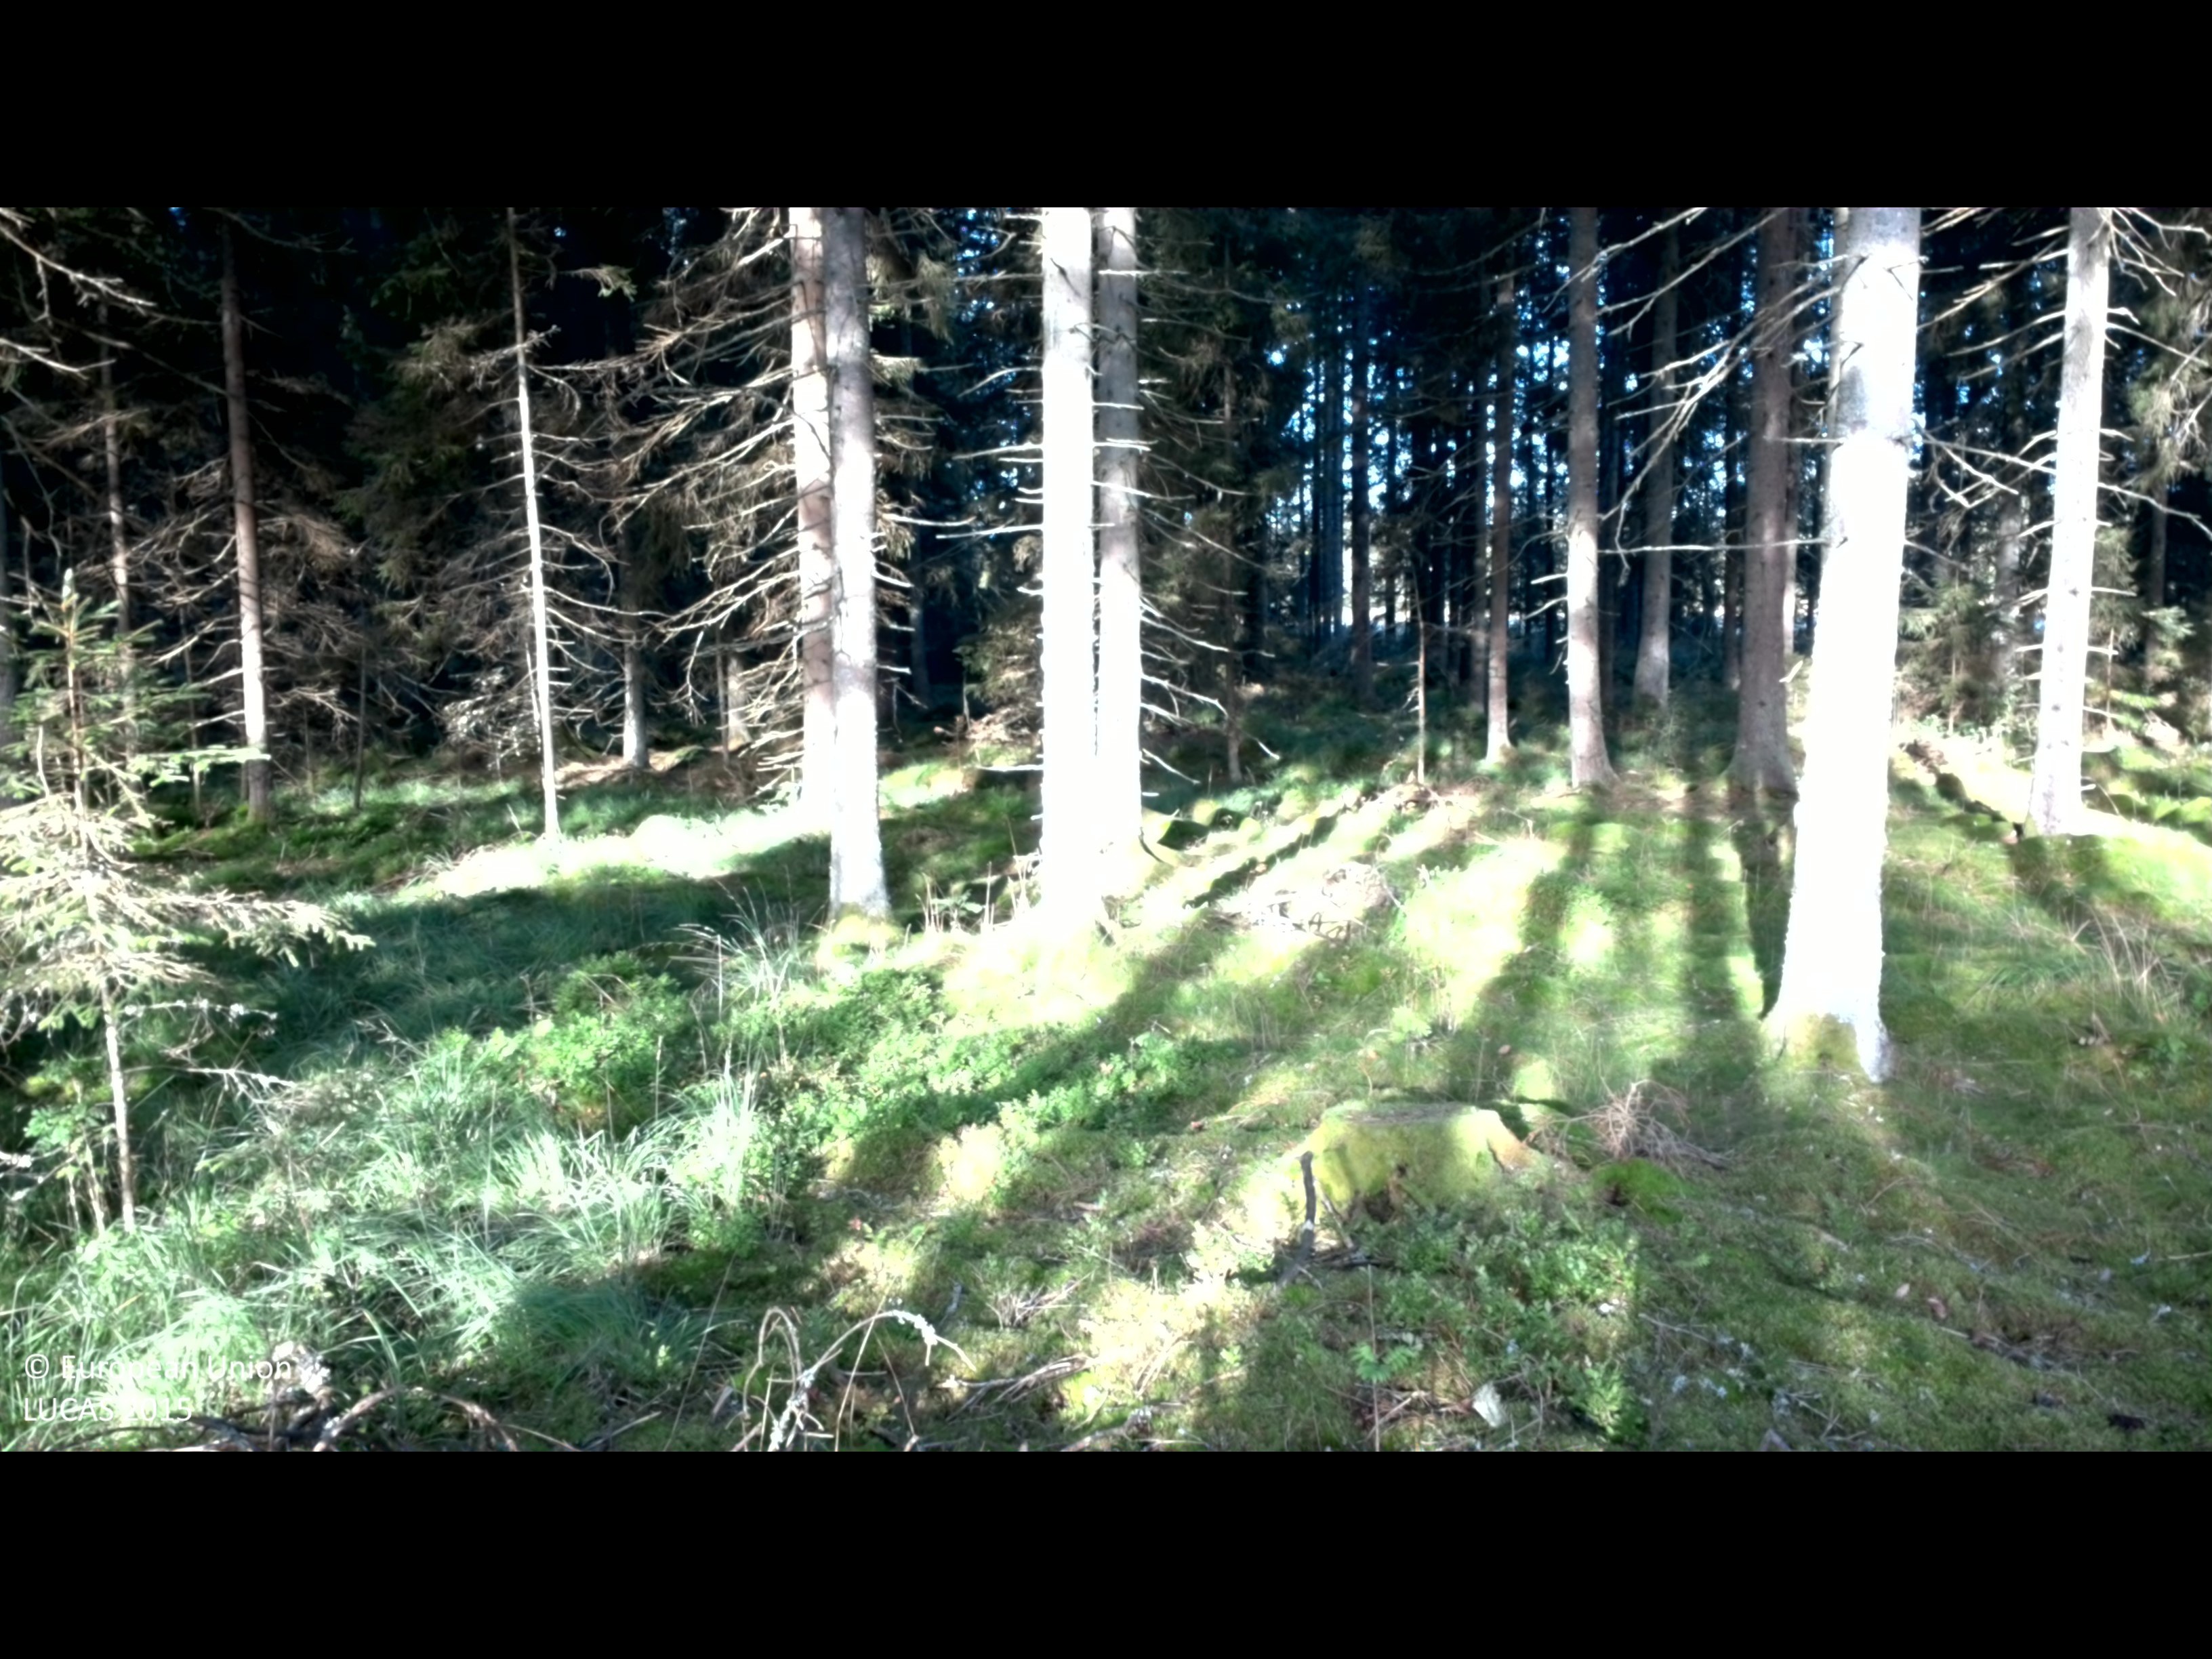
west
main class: Woodland
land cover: Spruce dominated coniferous woodland
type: boreal forest
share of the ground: 50 - 75 %
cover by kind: coniferous forest trees 60 %, shrubs 15 %, lichens and mosses 15 %, herbaceous plants 10 %
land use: Forestry
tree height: > 5 m
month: September
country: SE
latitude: 57.1020
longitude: 13.1823
